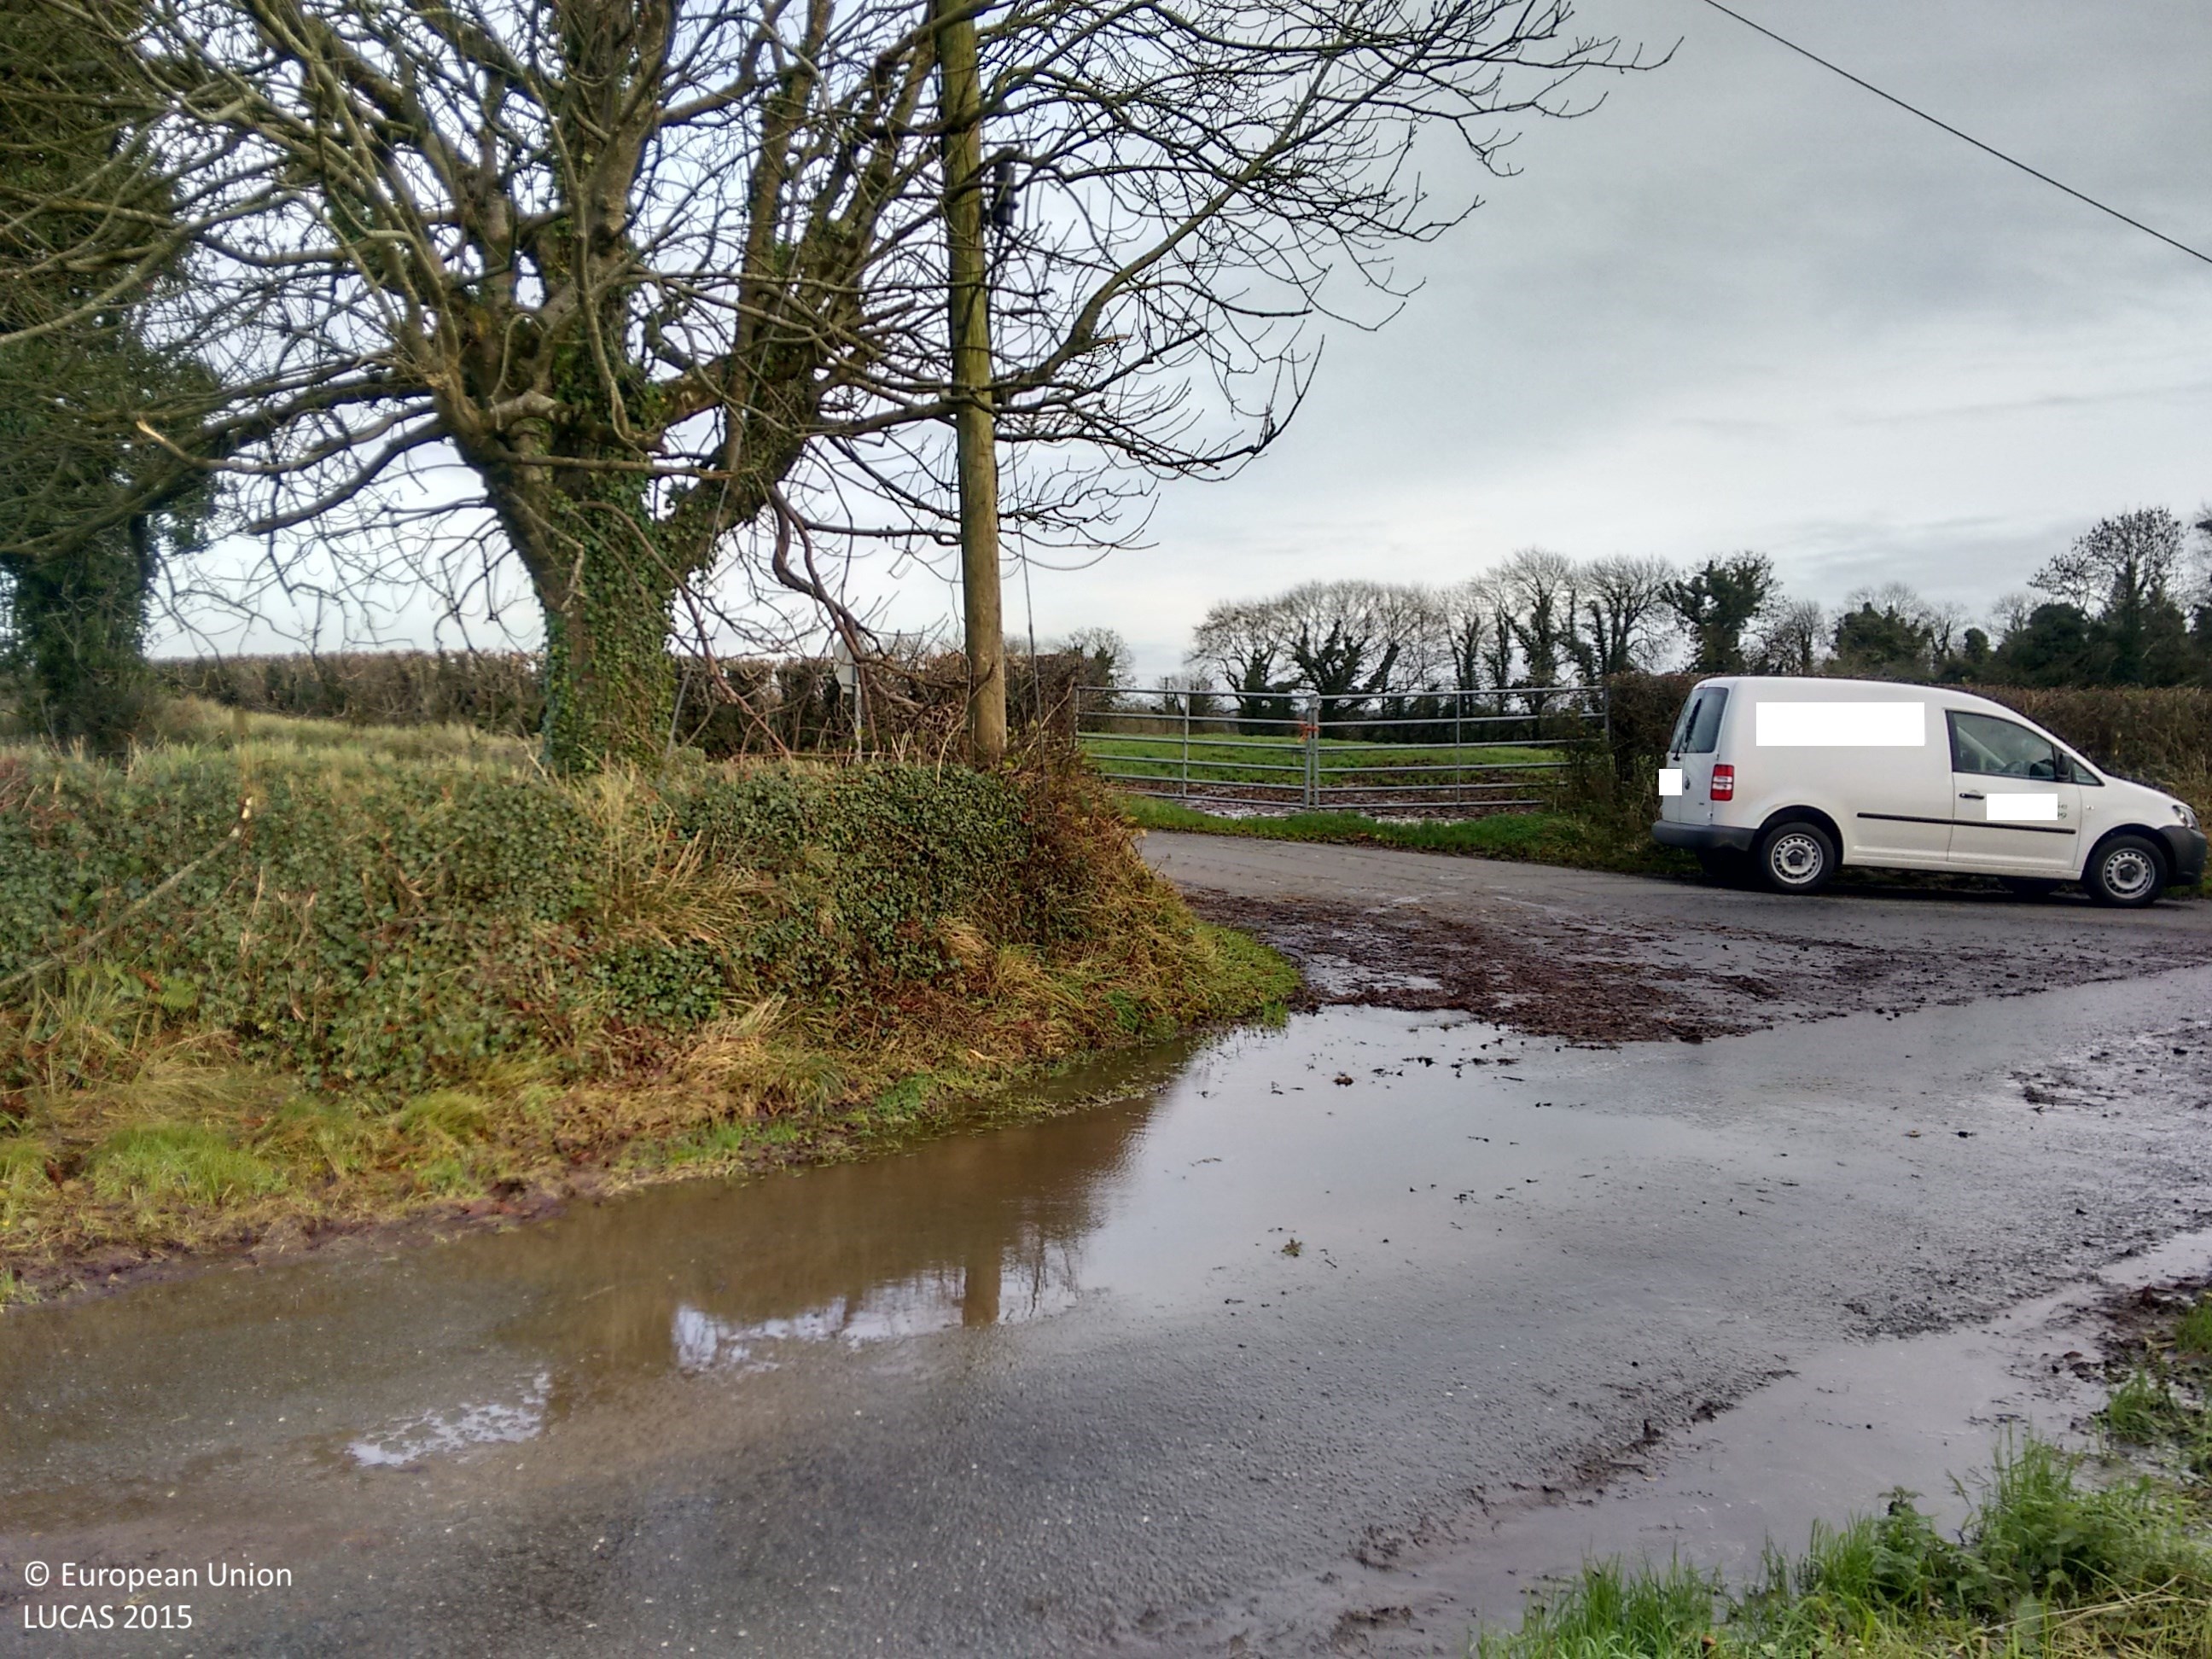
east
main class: Grassland
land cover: Grassland without tree/shrub cover
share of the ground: > 75 %
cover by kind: herbaceous plants 100 %
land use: Agriculture (excluding fallow land and kitchen gardens)
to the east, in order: Grassland without tree/shrub cover; Broadleaved woodland; Fences; Grassland without tree/shrub cover; Fences; Managed hedges; Grassland without tree/shrub cover; Ditches and canals; Fences; Grassland without tree/shrub cover; Ditches and canals; Managed hedges; Electric lines; Grass margins; Paved roads, cycling and walking lanes; Grass margins; Broadleaved woodland; Grassland without tree/shrub cover
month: November
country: IE
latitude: 53.7671
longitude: -7.7806
